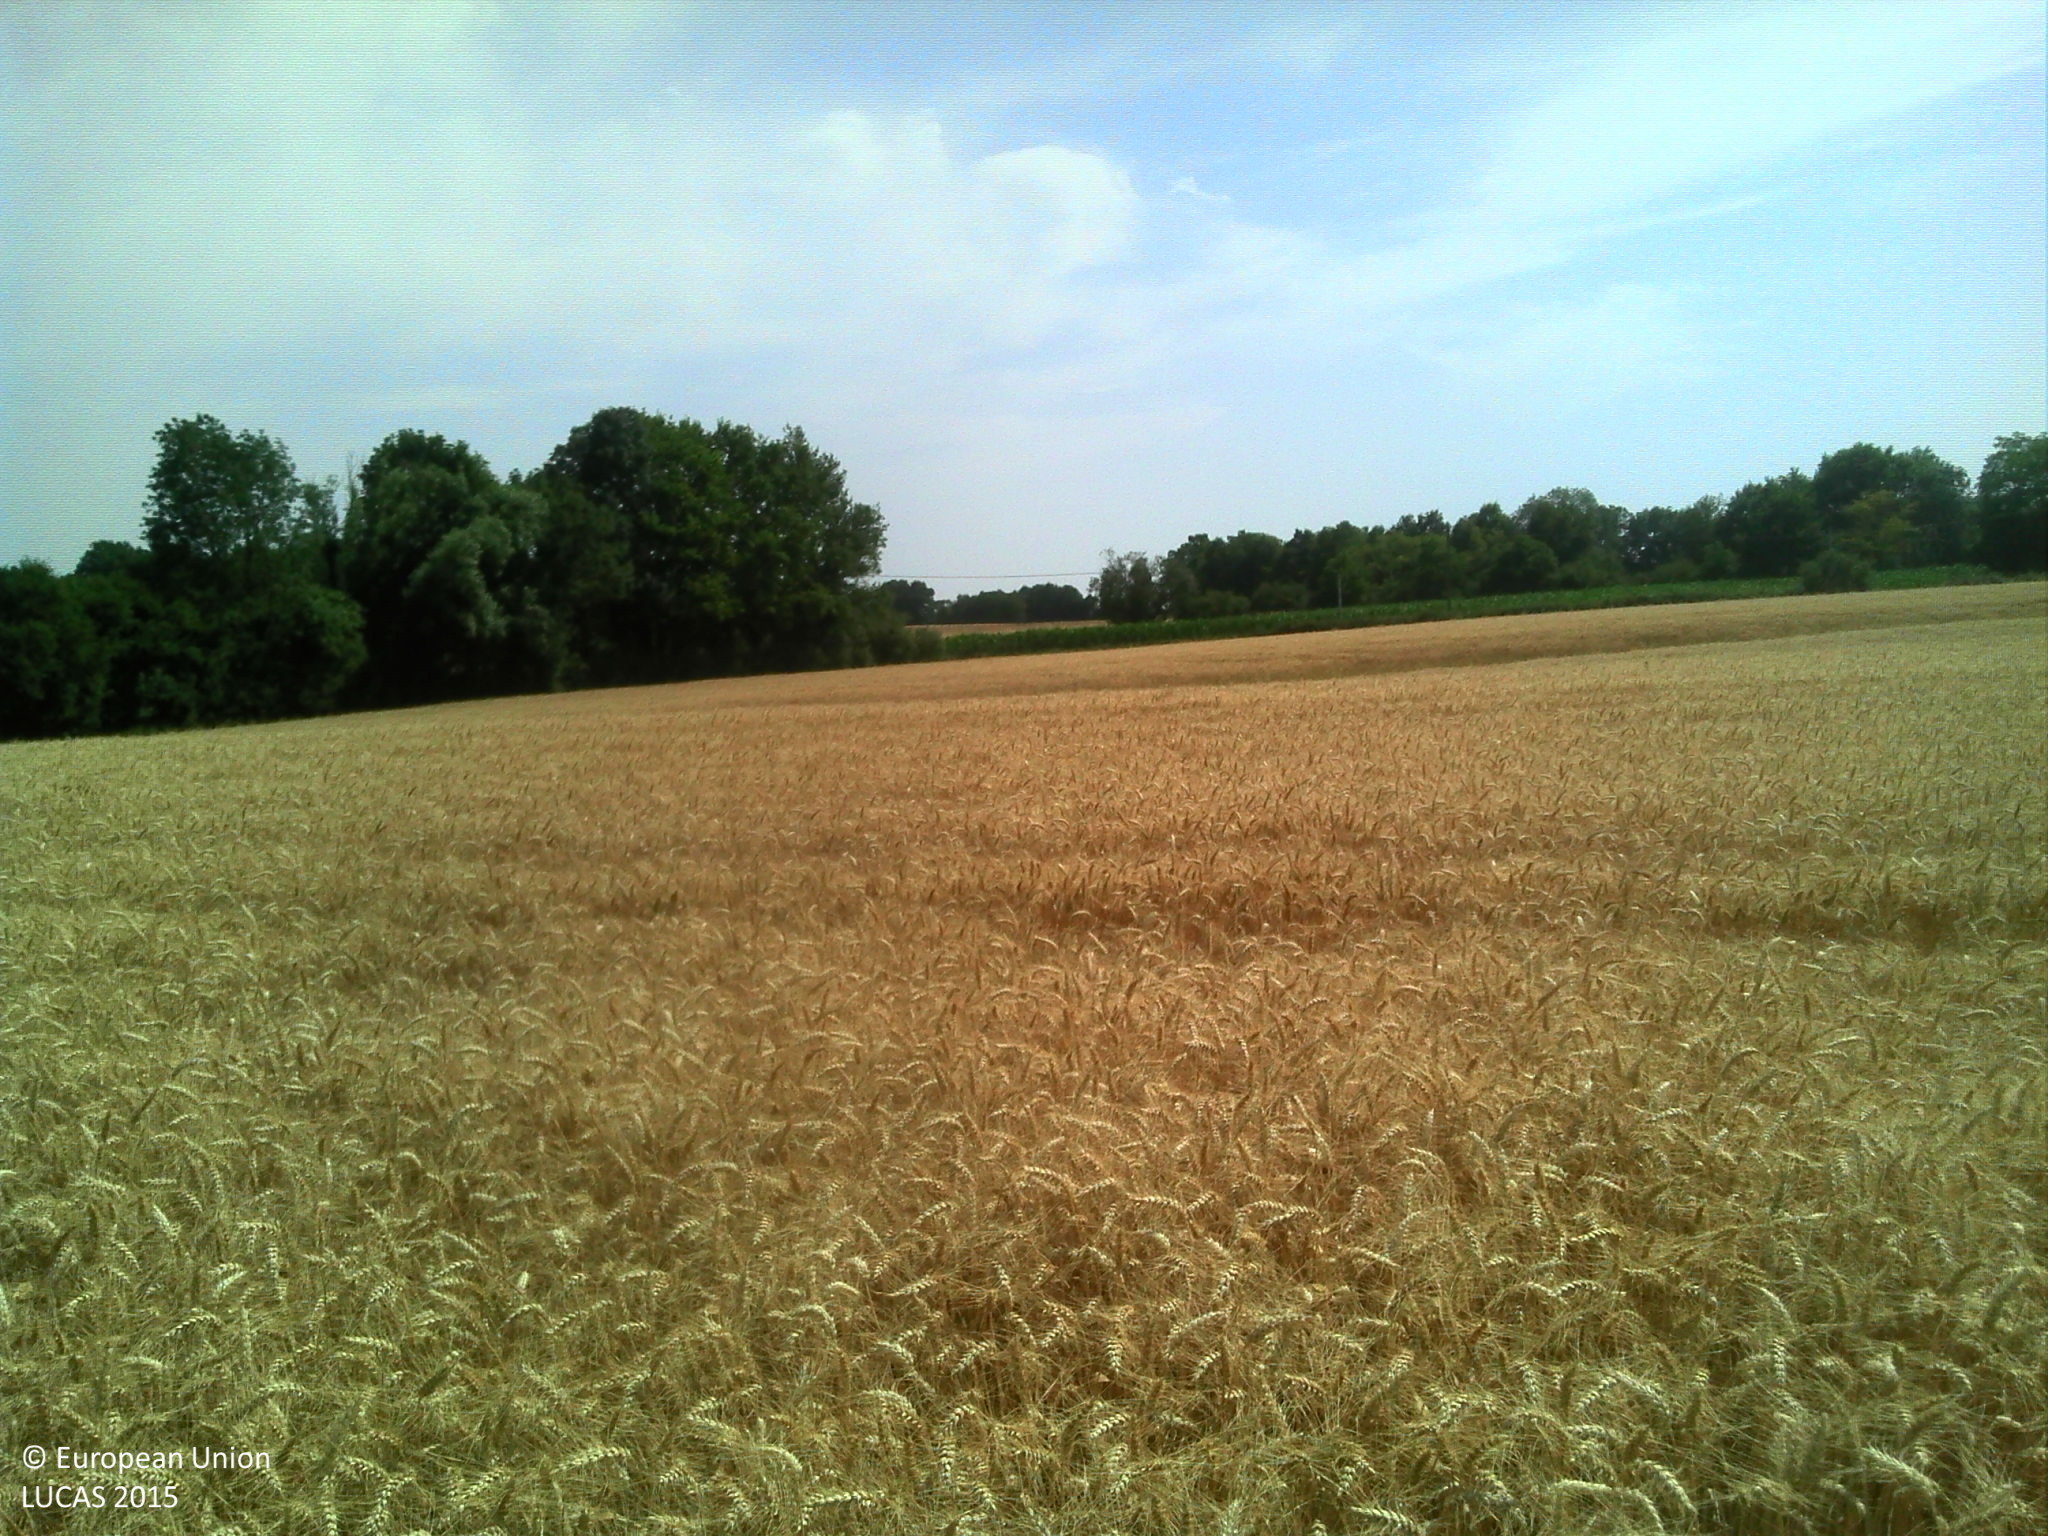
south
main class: Cropland
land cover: Barley
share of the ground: > 75 %
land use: Agriculture (excluding fallow land and kitchen gardens)
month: July
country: FR
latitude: 46.8250
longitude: 5.2959
